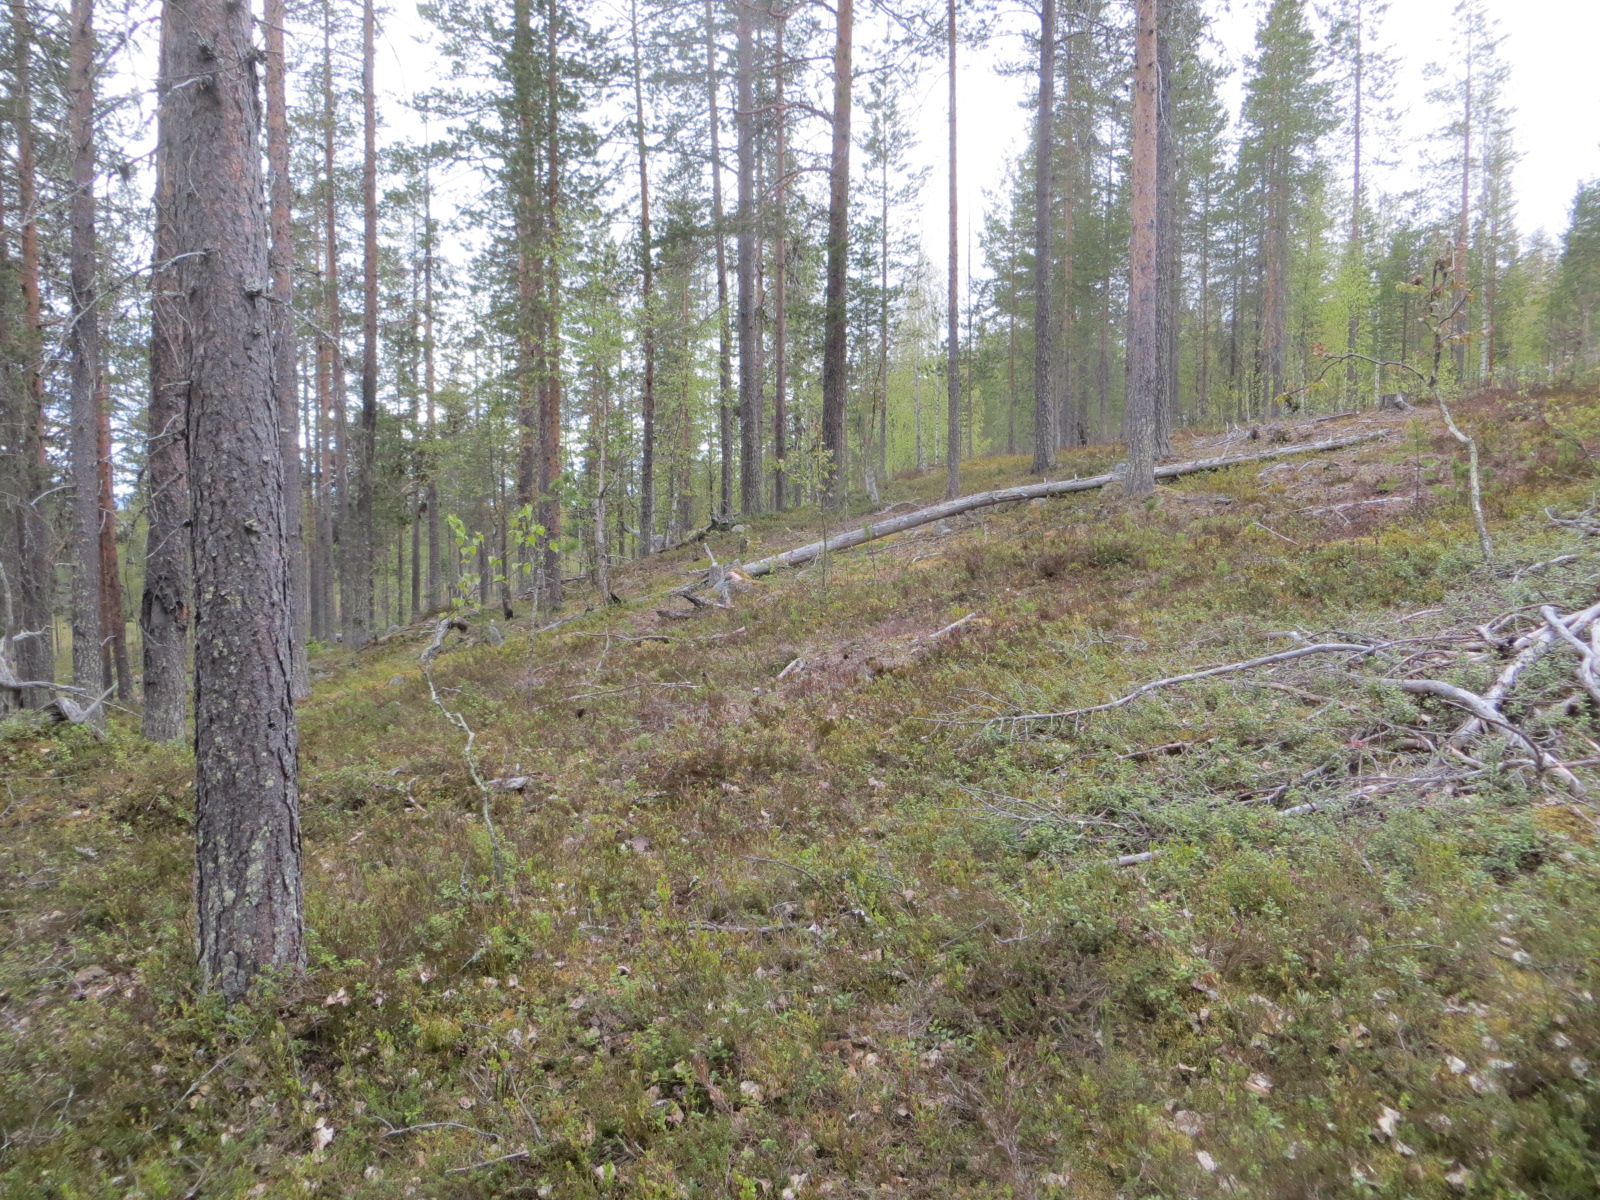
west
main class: Woodland
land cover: Pine dominated coniferous woodland
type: boreal forest
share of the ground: 50 - 75 %
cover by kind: coniferous forest trees 65 %, shrubs 15 %, broadleaved forest trees 10 %, herbaceous plants 5 %, lichens and mosses 5 %
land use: Forestry
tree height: > 5 m
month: June
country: FI
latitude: 67.5705
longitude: 25.7657
